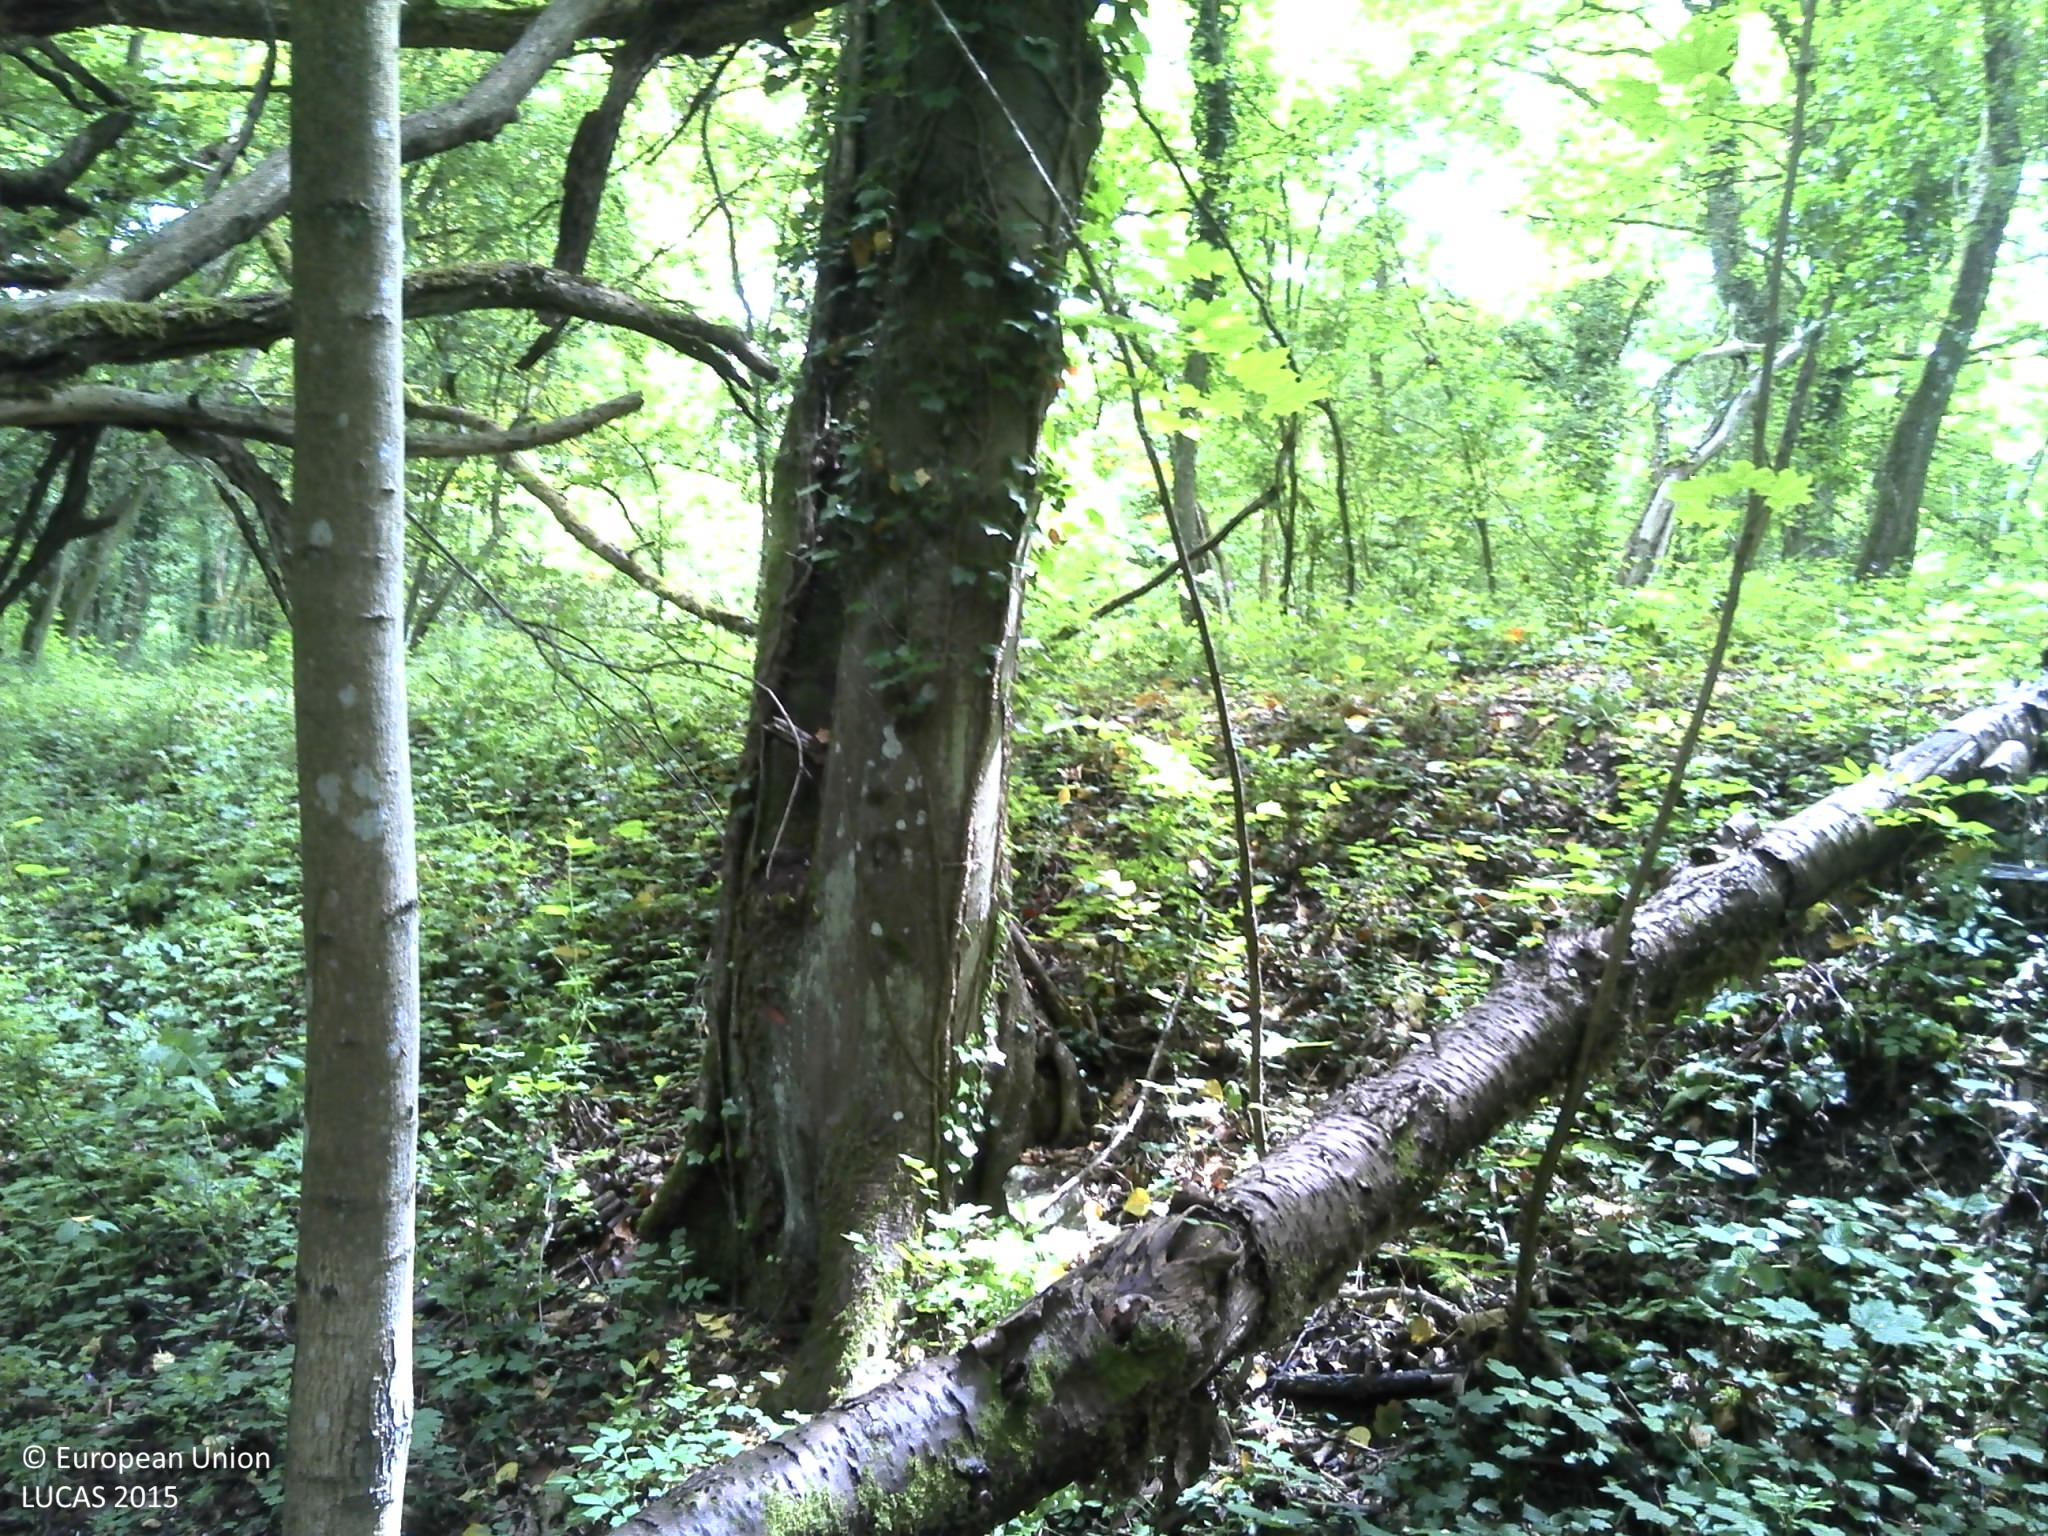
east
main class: Woodland
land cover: Broadleaved woodland
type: mesophytic deciduous forest
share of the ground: > 75 %
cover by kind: broadleaved forest trees 95 %, shrubs 5 %
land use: Semi-natural and natural areas not in use
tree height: > 5 m
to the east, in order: Broadleaved woodland; Dry stone walls; Fences; Broadleaved woodland; Tracks; Broadleaved woodland; Fences; Grassland without tree/shrub cover; Fences; Grassland without tree/shrub cover; Fences; Conifer hedges; Broadleaved woodland
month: June
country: FR
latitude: 49.0239
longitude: 6.2391
